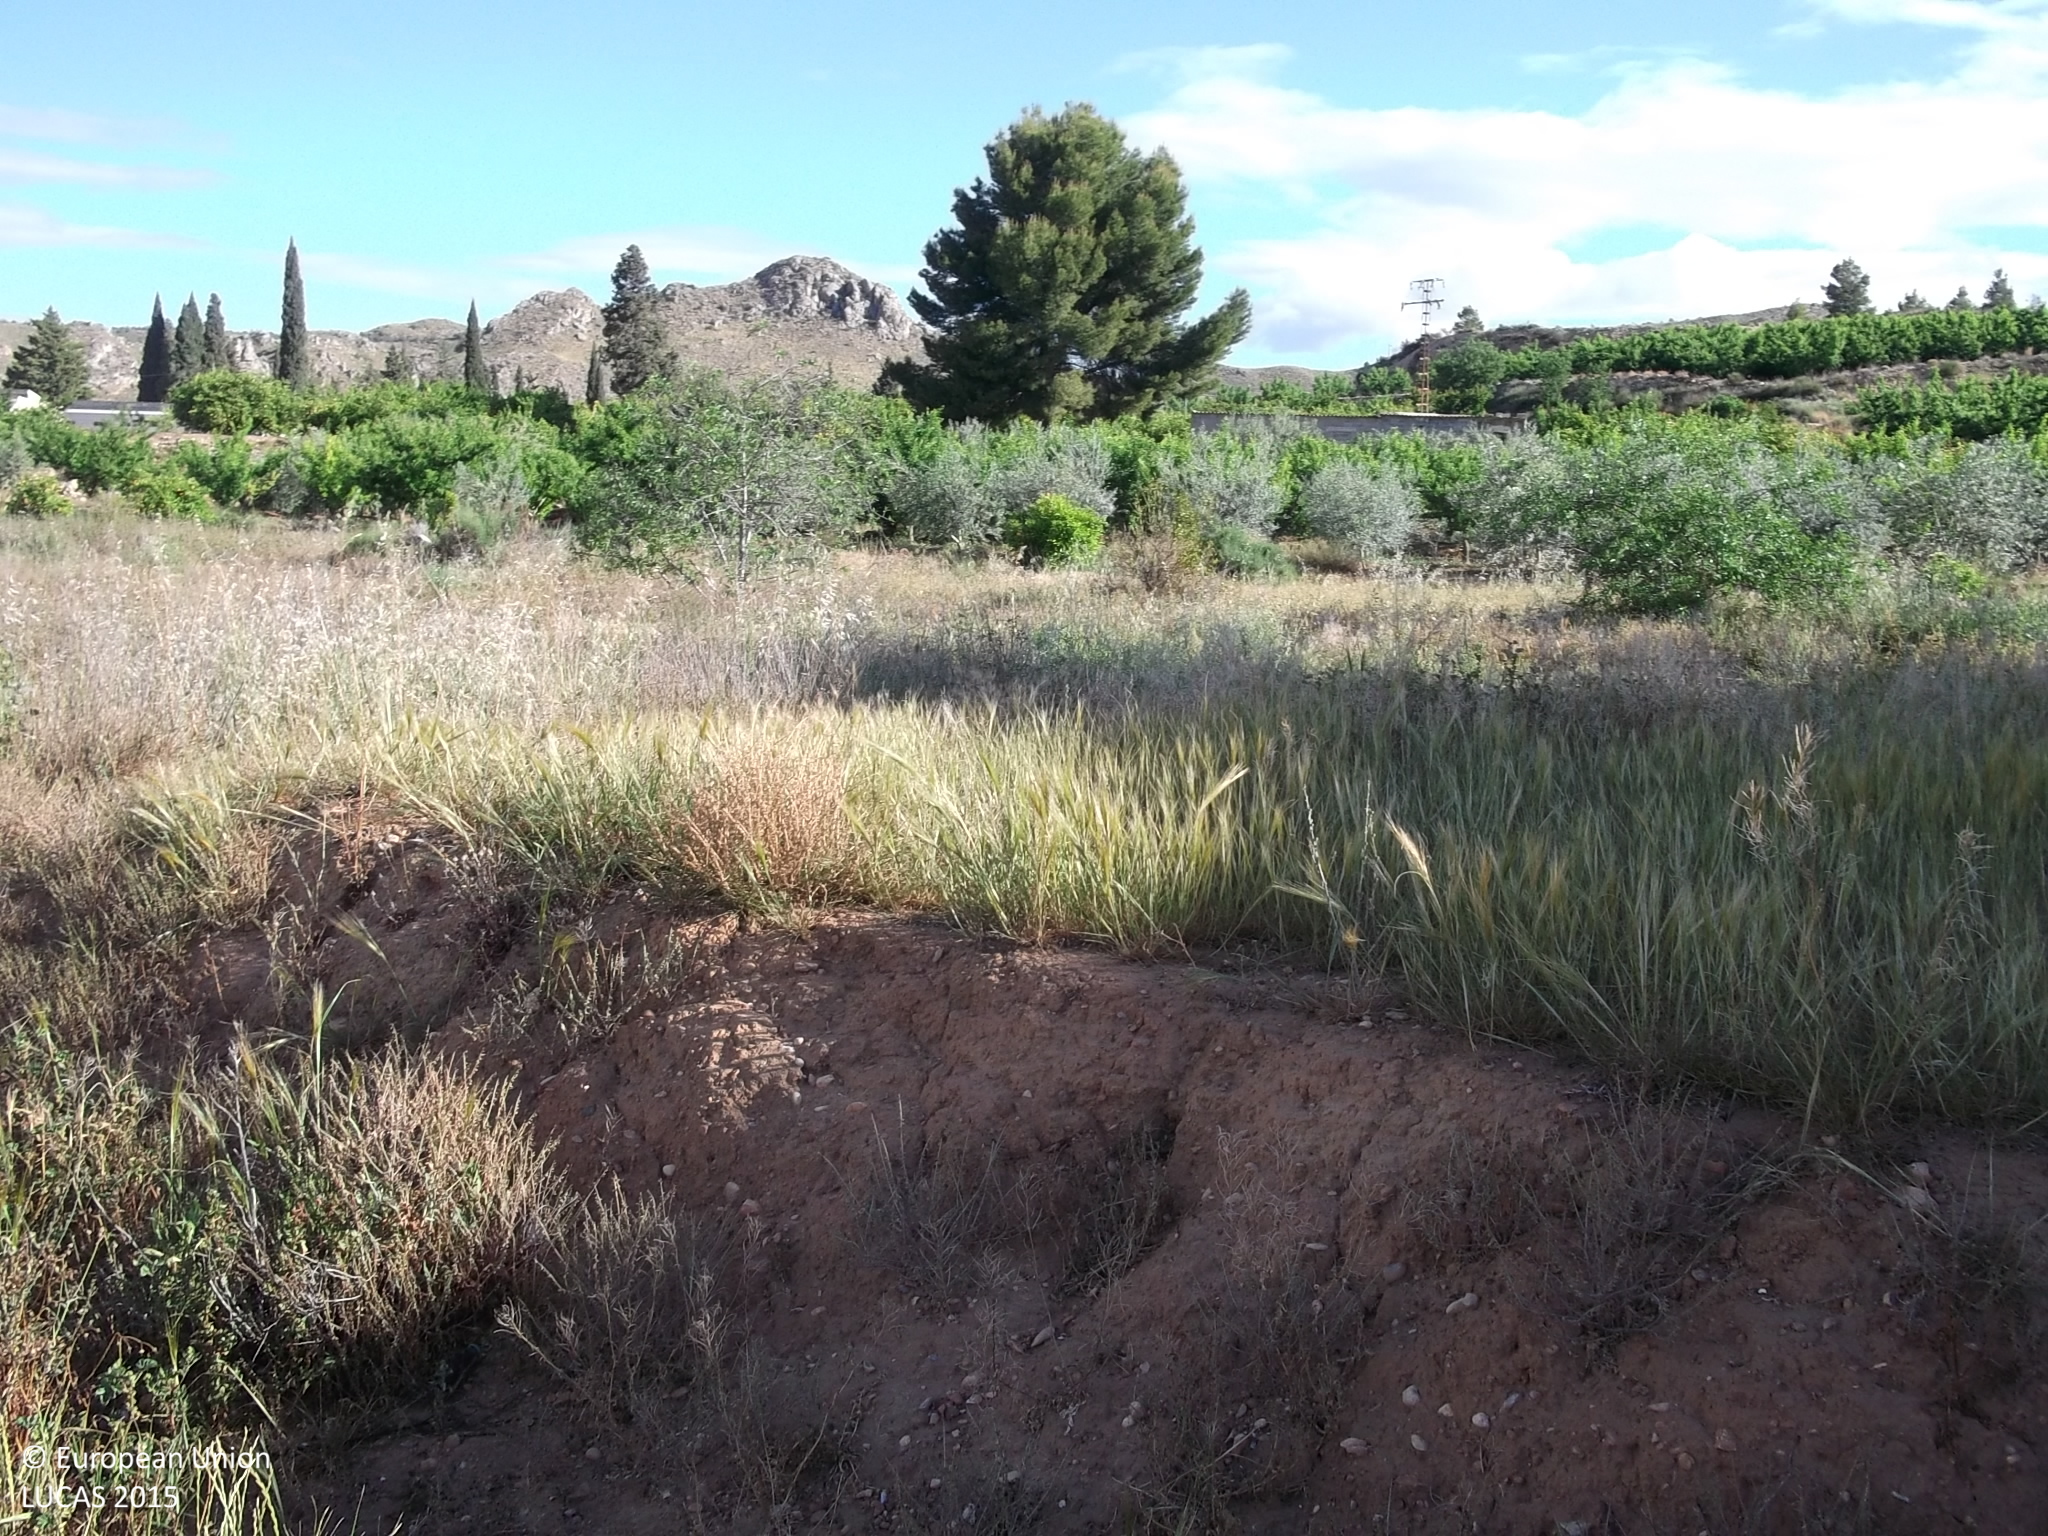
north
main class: Grassland
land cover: Spontaneously vegetated surfaces
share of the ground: > 75 %
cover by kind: herbaceous plants 90 %, consolidated bare surface 10 %
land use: Abandoned areas
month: April
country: ES
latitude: 38.2123
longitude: -1.3975
